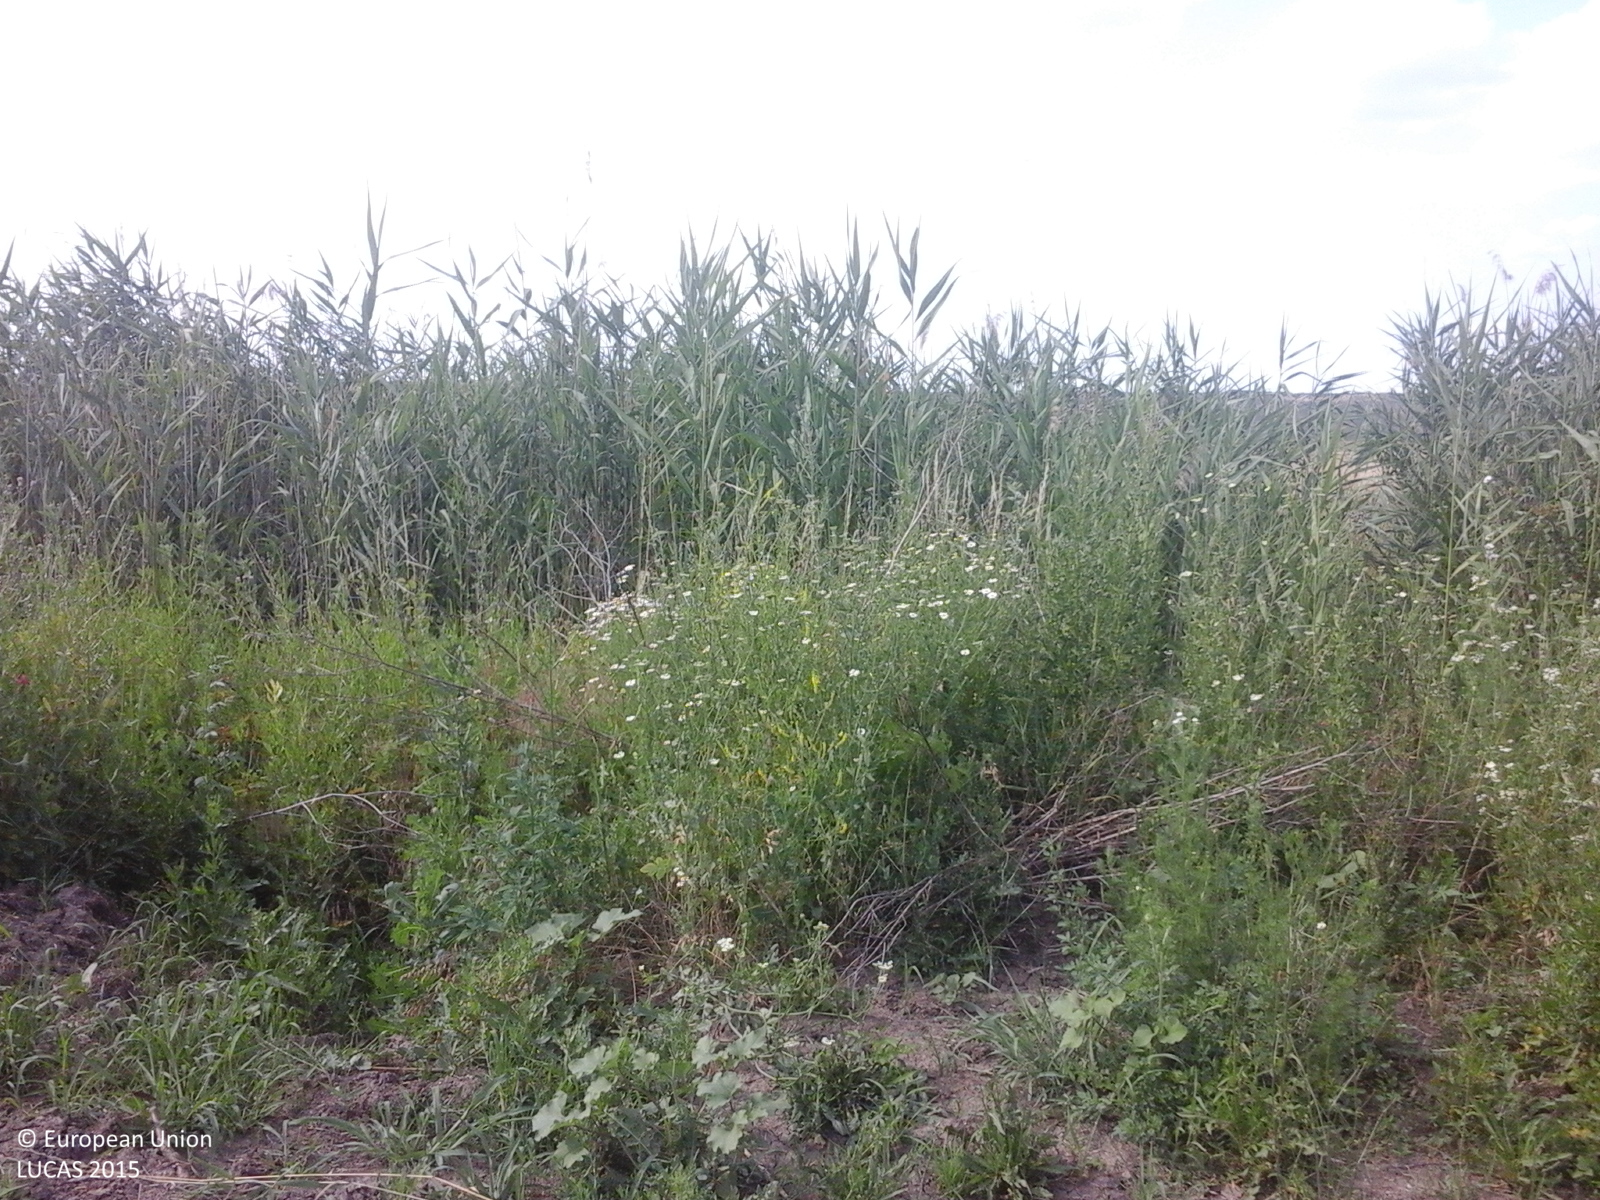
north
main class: Grassland
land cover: Spontaneously vegetated surfaces
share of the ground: > 75 %
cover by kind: herbaceous plants 100 %
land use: Semi-natural and natural areas not in use
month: June
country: RO
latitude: 44.0968
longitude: 26.5383
